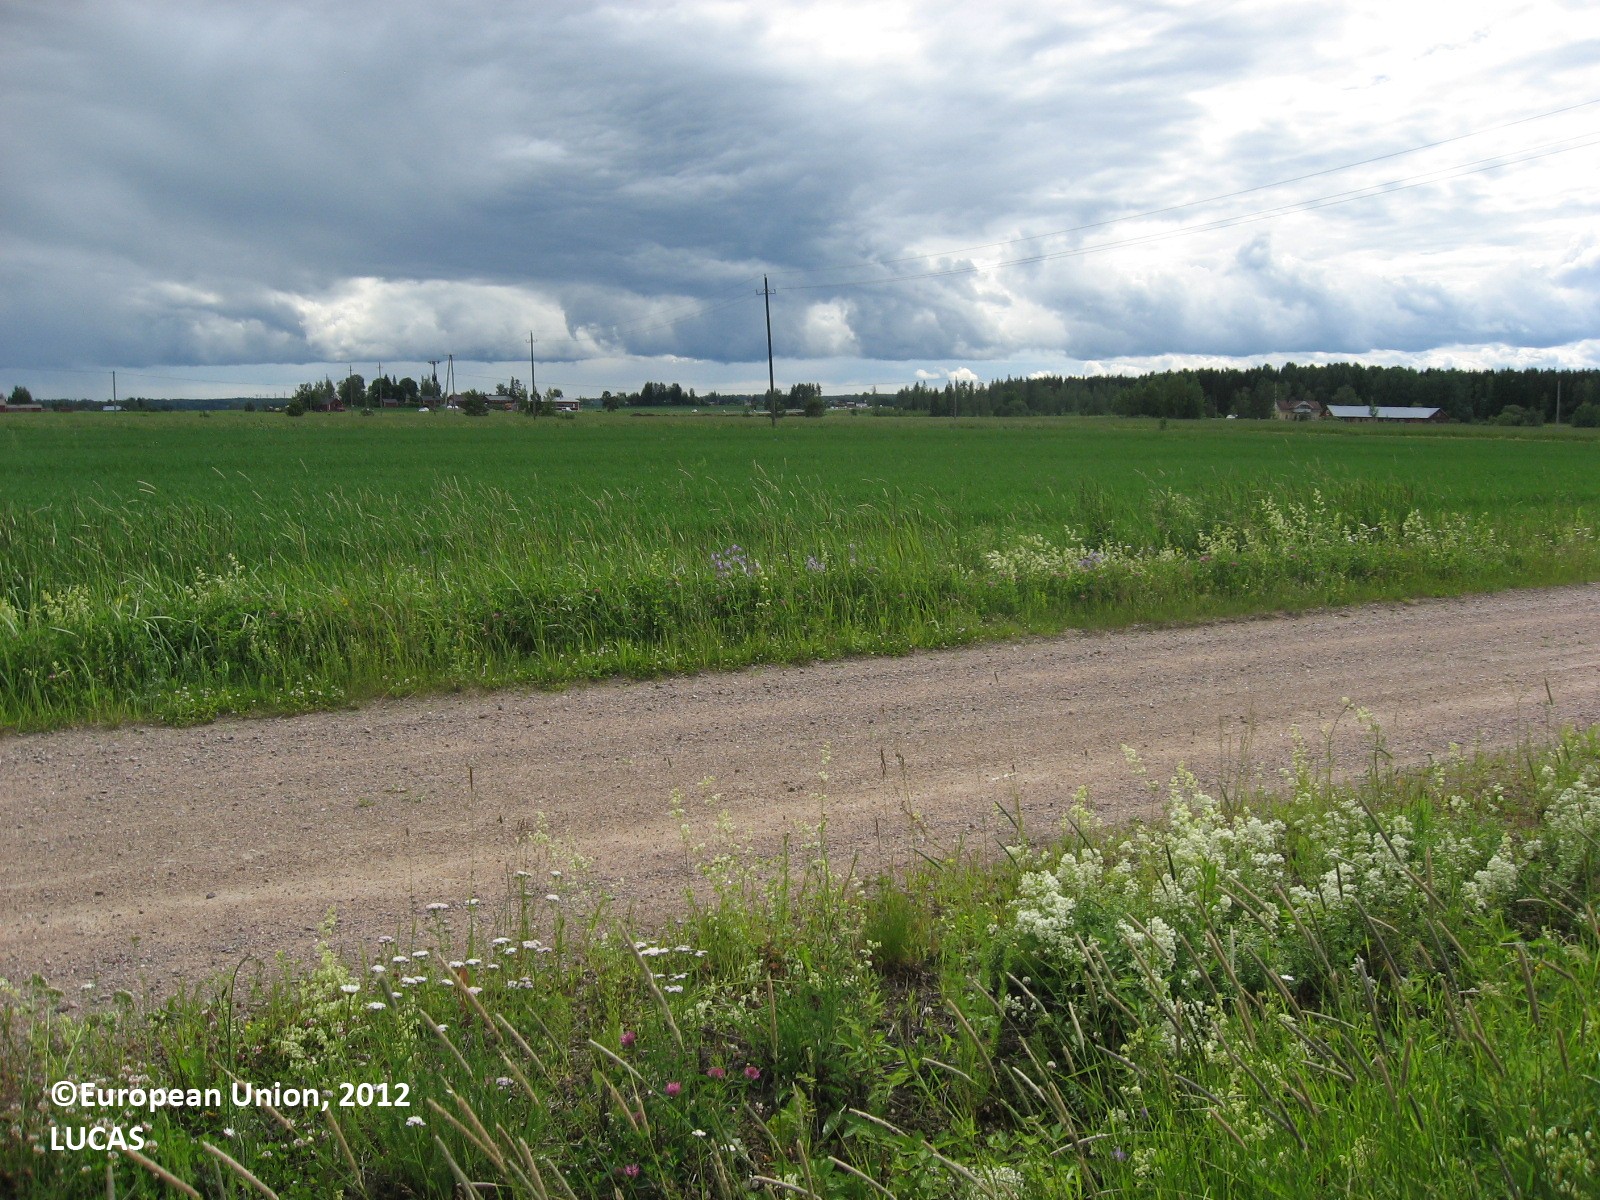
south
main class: Cropland
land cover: Oats
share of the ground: > 75 %
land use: Agriculture (excluding fallow land and kitchen gardens)
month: June
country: FI
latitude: 60.7707
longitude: 26.4739
